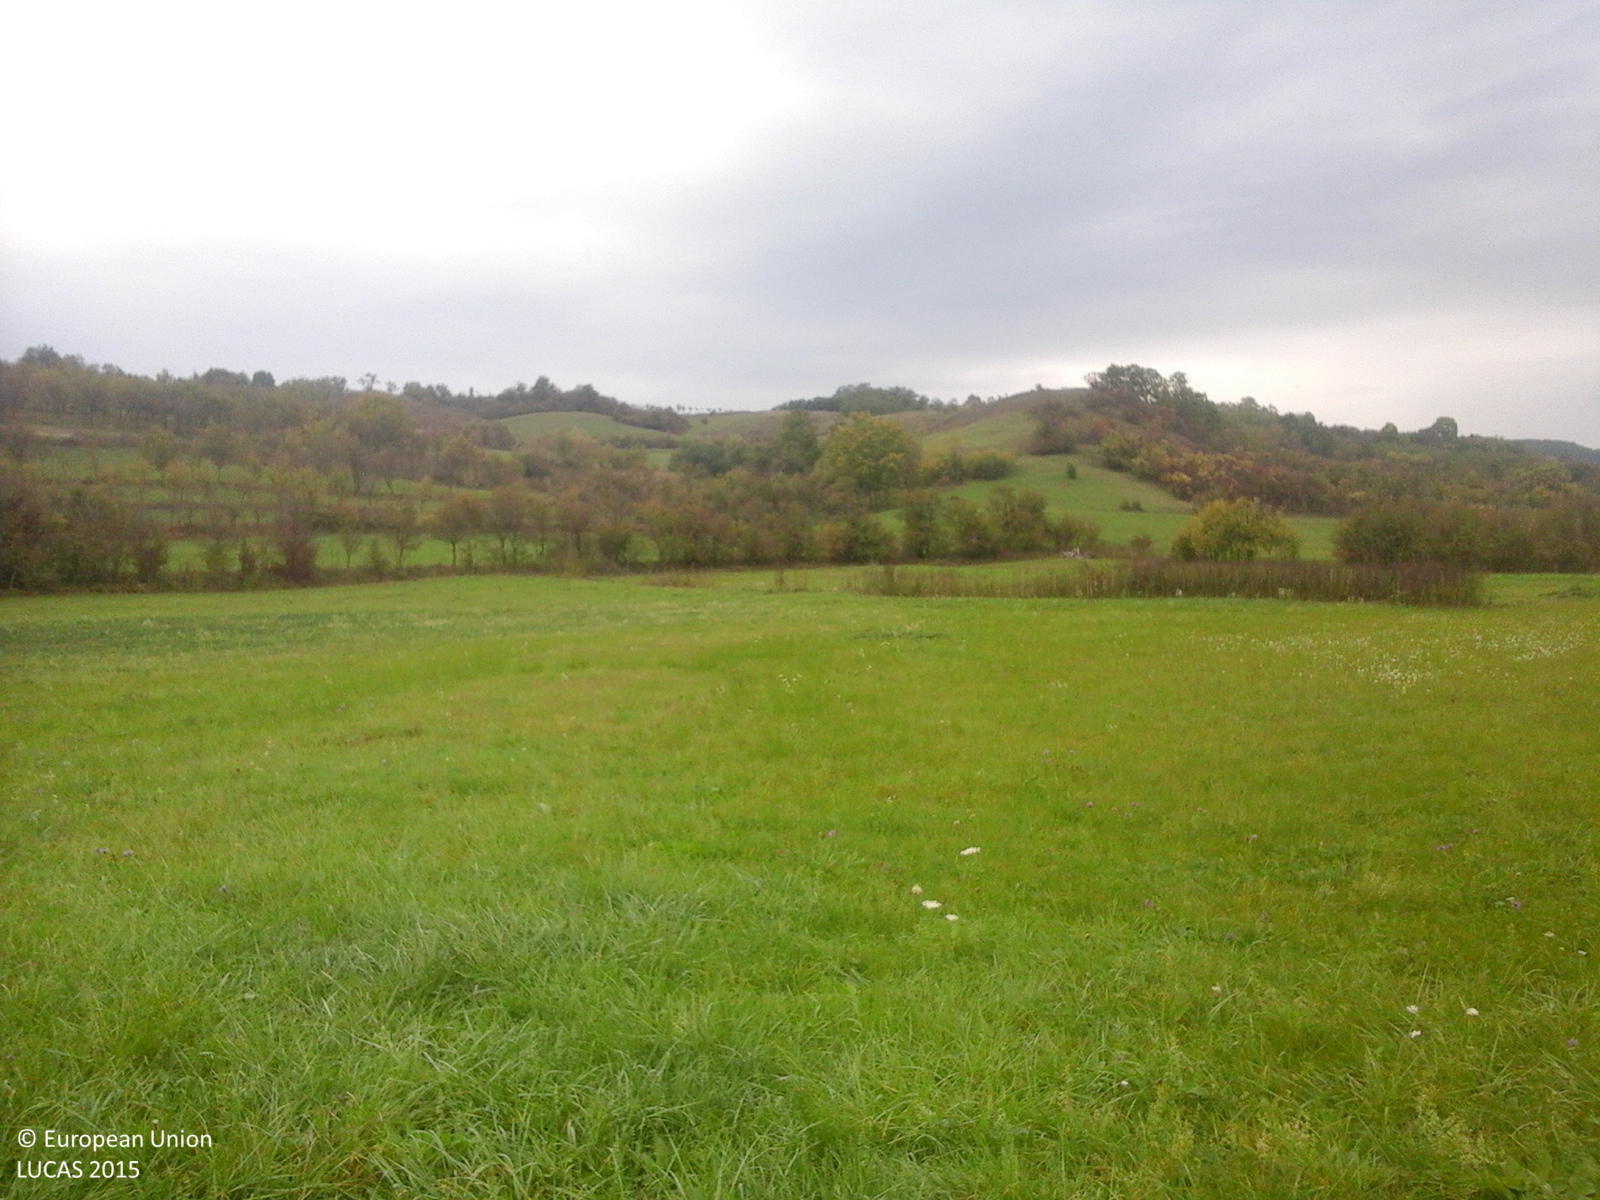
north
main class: Grassland
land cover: Grassland without tree/shrub cover
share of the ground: > 75 %
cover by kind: herbaceous plants 100 %
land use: Agriculture (excluding fallow land and kitchen gardens)
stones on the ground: < 10 %
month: October
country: RO
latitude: 46.5205
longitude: 24.9433
